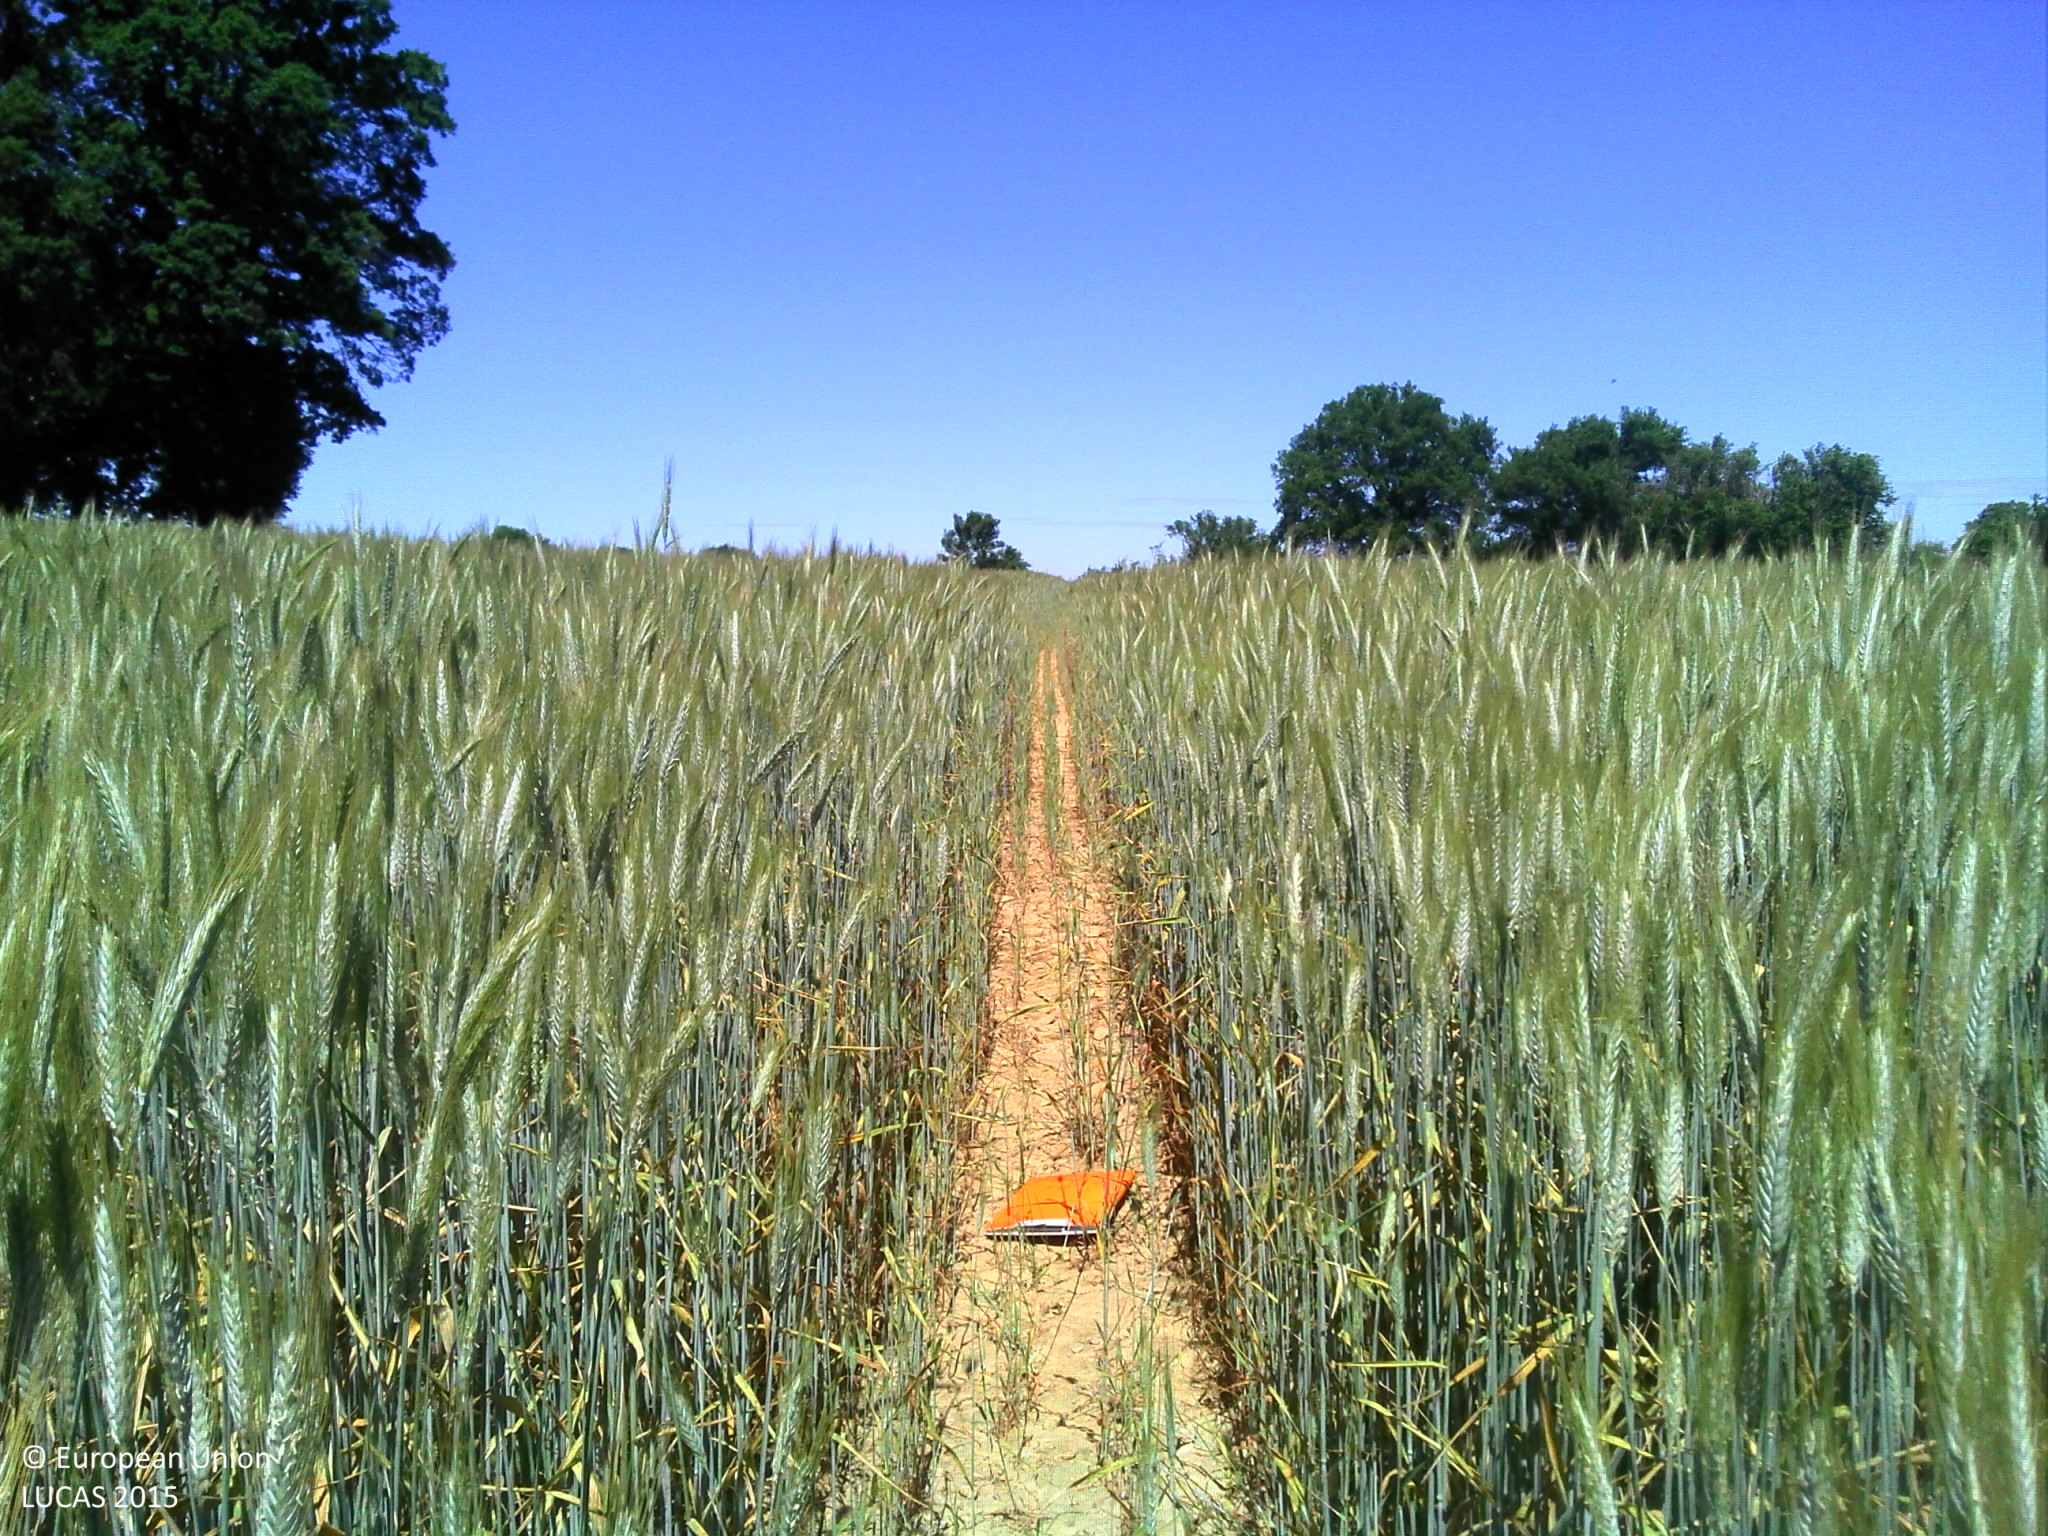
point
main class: Cropland
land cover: Triticale
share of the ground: > 75 %
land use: Agriculture (excluding fallow land and kitchen gardens)
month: June
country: FR
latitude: 46.4372
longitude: 2.3285
